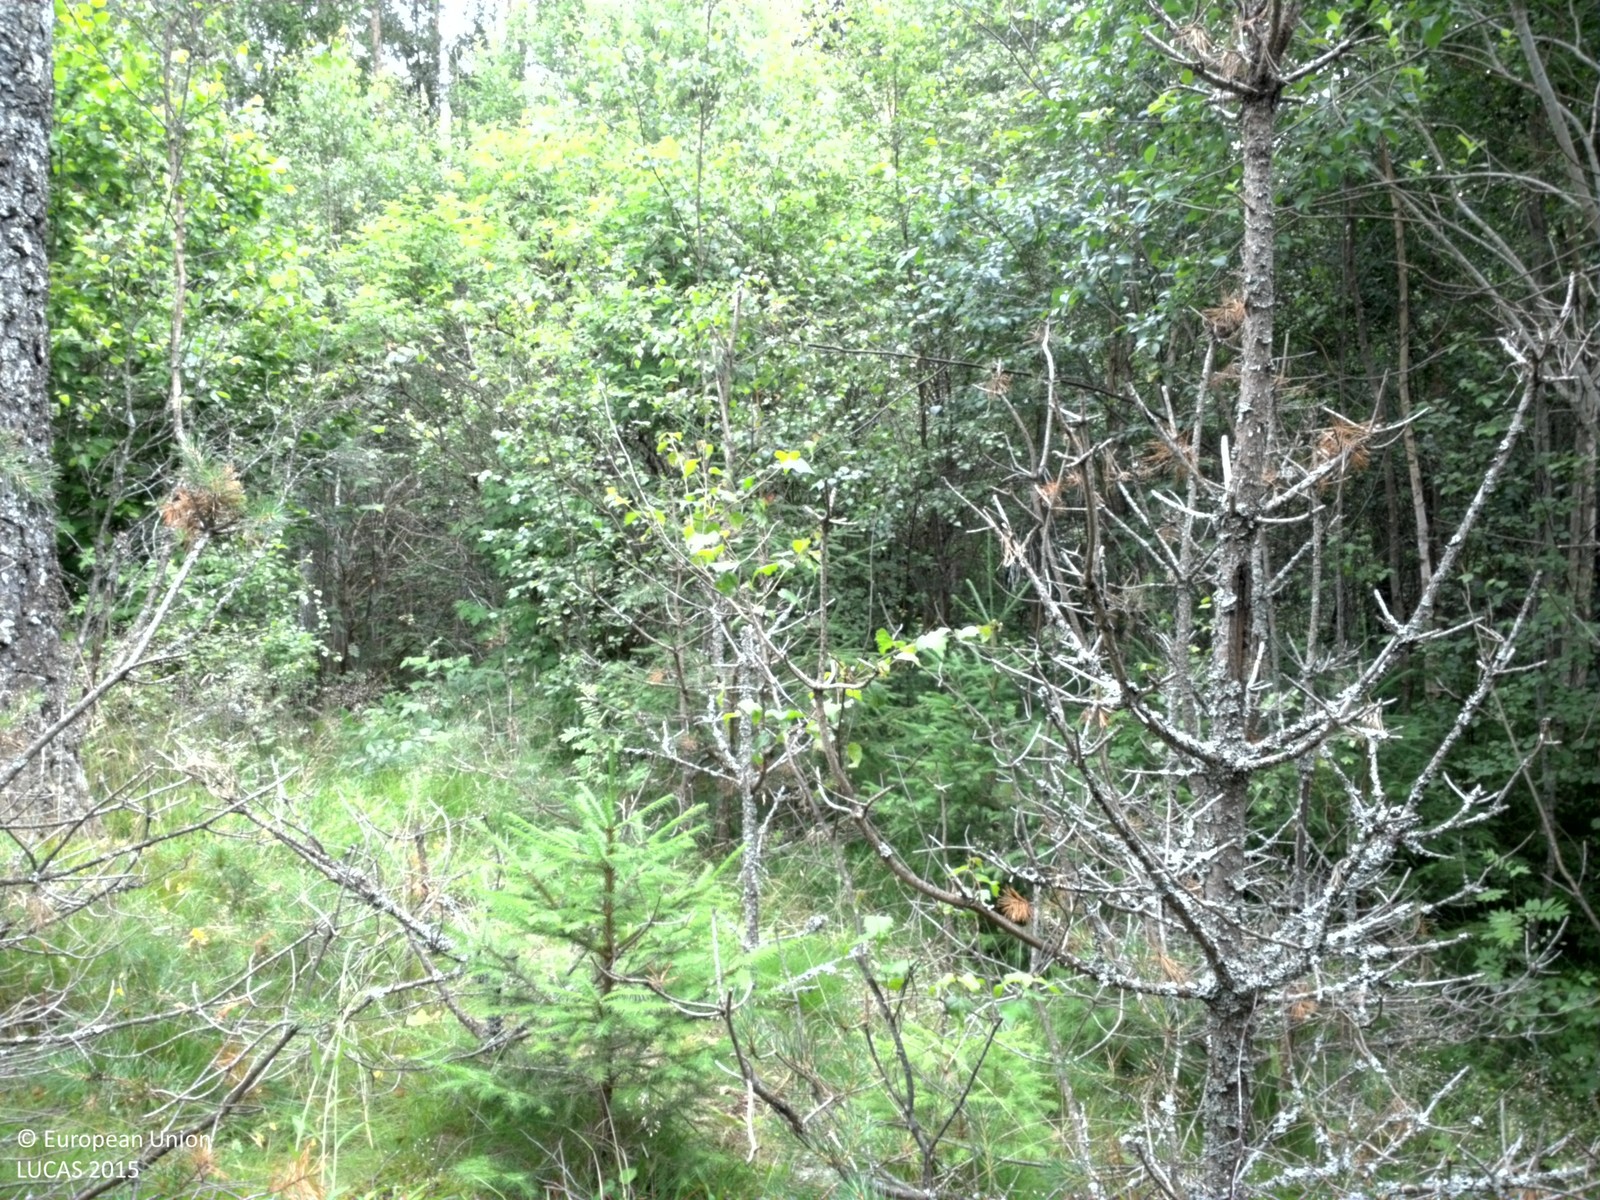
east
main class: Woodland
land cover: Broadleaved woodland
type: hemiboreal forest and nemoral coniferous forest and mixed broadleaved-coniferous forest
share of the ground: > 75 %
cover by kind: broadleaved forest trees 80 %, herbaceous plants 20 %
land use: Forestry
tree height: < 5 m
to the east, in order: Broadleaved woodland; Pine dominated mixed woodland; Inland fresh running water; Spruce dominated coniferous woodland; Ditches and canals; Spruce dominated coniferous woodland
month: July
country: SE
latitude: 57.5228
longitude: 14.7546
